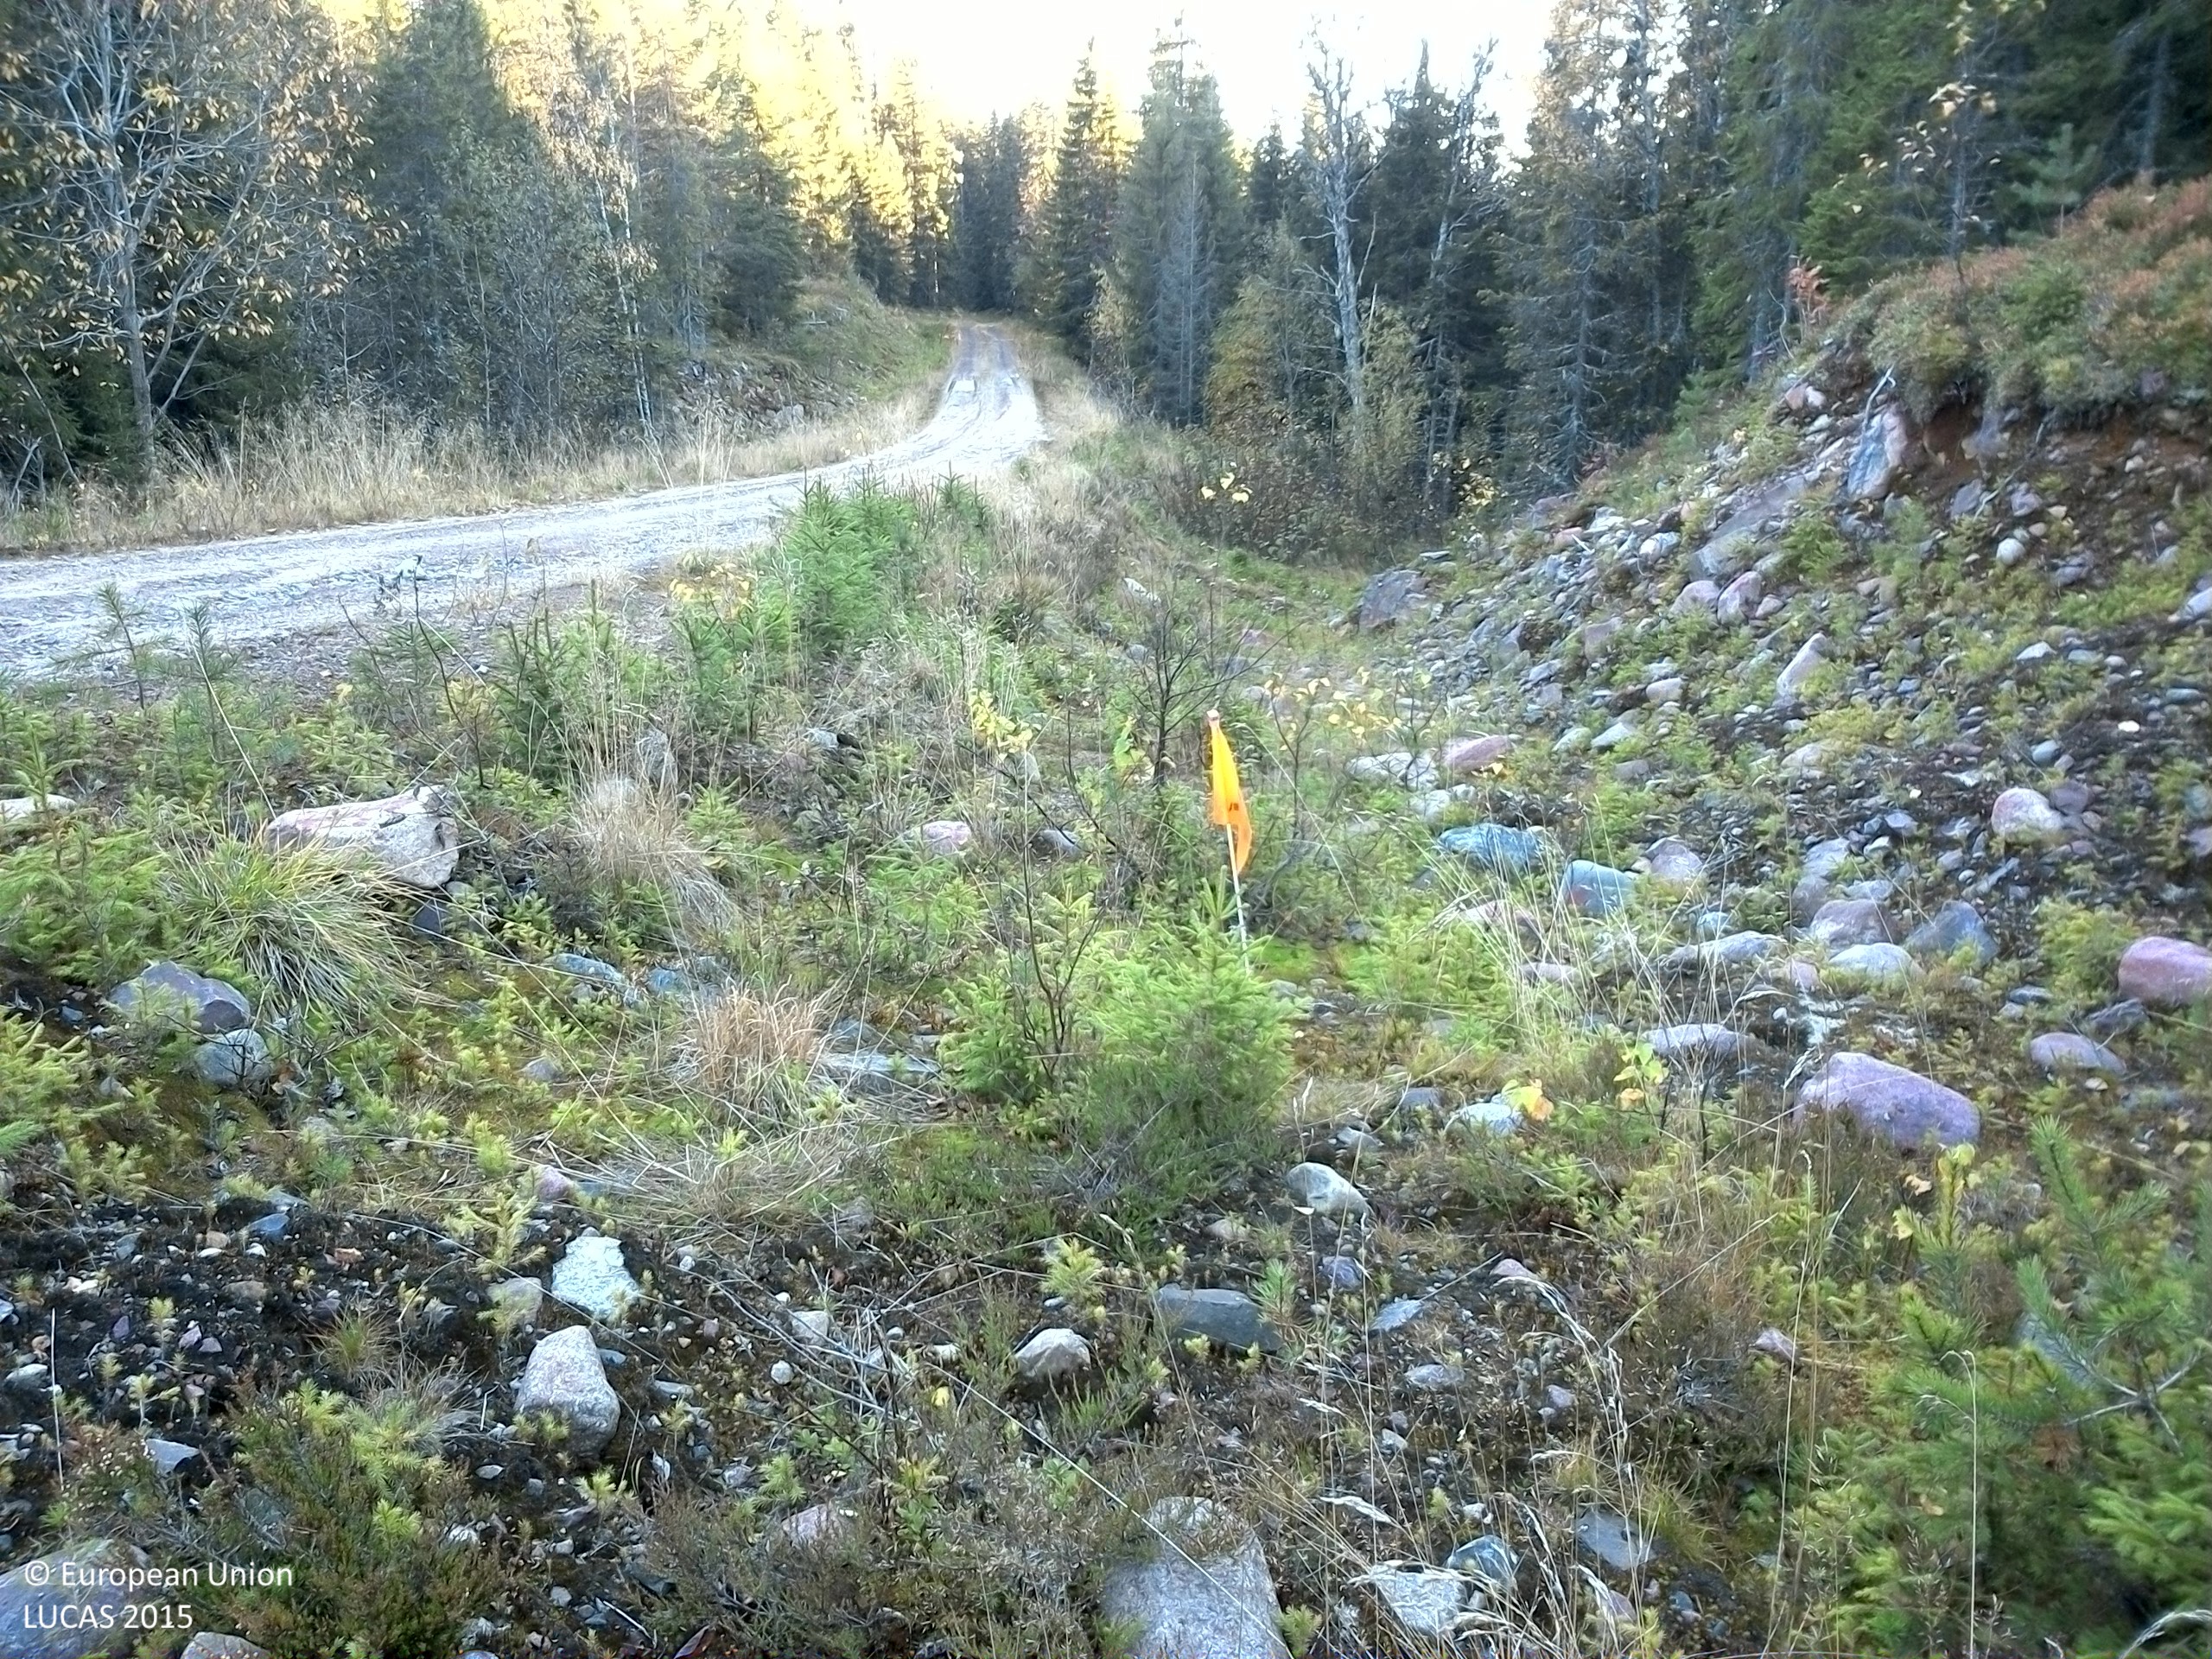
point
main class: Woodland
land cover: Spruce dominated mixed woodland
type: boreal forest
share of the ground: 25 - 50 %
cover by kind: shrubs 30 %, coniferous forest trees 25 %, consolidated bare surface 25 %, broadleaved forest trees 10 %, herbaceous plants 10 %
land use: Road transport
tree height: < 5 m
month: October
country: SE
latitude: 61.2701
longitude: 14.8528
